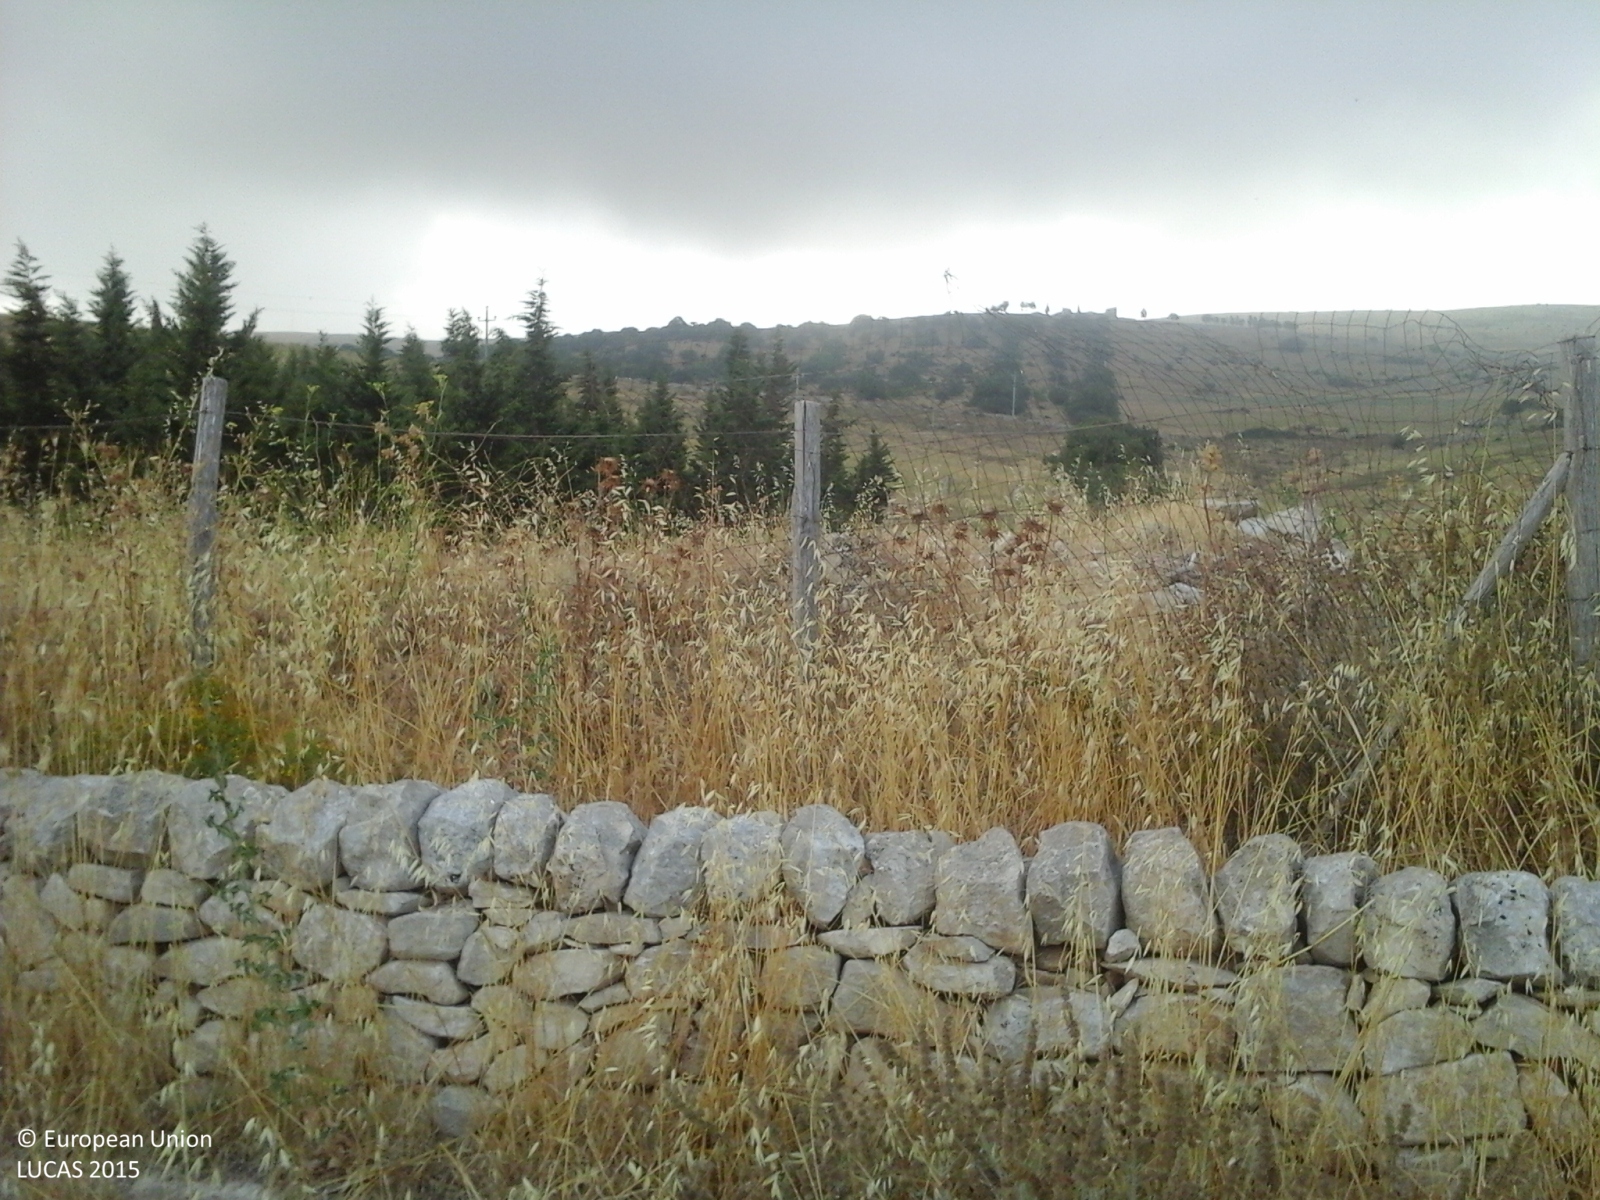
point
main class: Grassland
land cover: Grassland with sparse tree/shrub cover
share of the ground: > 75 %
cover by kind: herbaceous plants 85 %, shrubs 10 %, coniferous forest trees 5 %
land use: Agriculture (excluding fallow land and kitchen gardens)
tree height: < 5 m
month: July
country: IT
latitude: 36.9791
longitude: 14.6479
